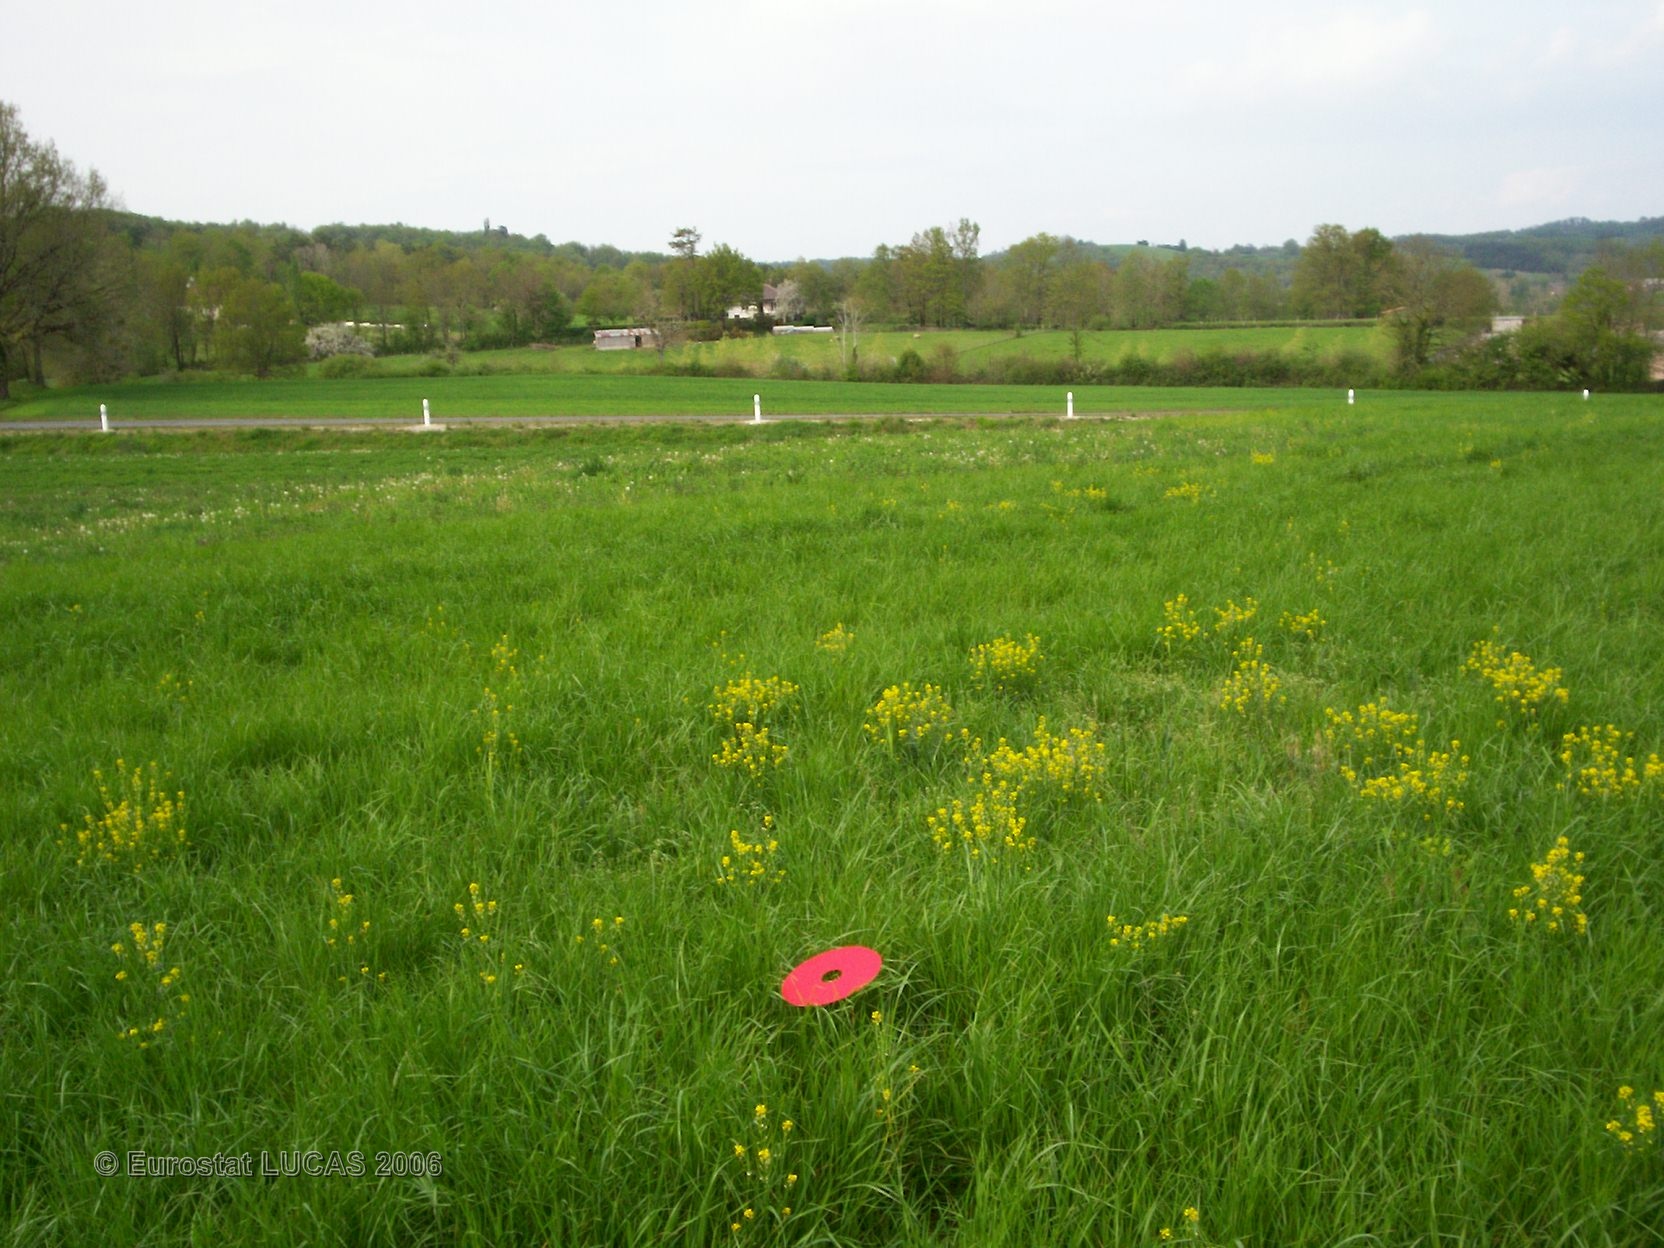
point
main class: Grassland
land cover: Grassland without tree/shrub cover
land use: Agriculture (excluding fallow land and kitchen gardens)
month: April
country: FR
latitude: 45.4953
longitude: 0.7369
